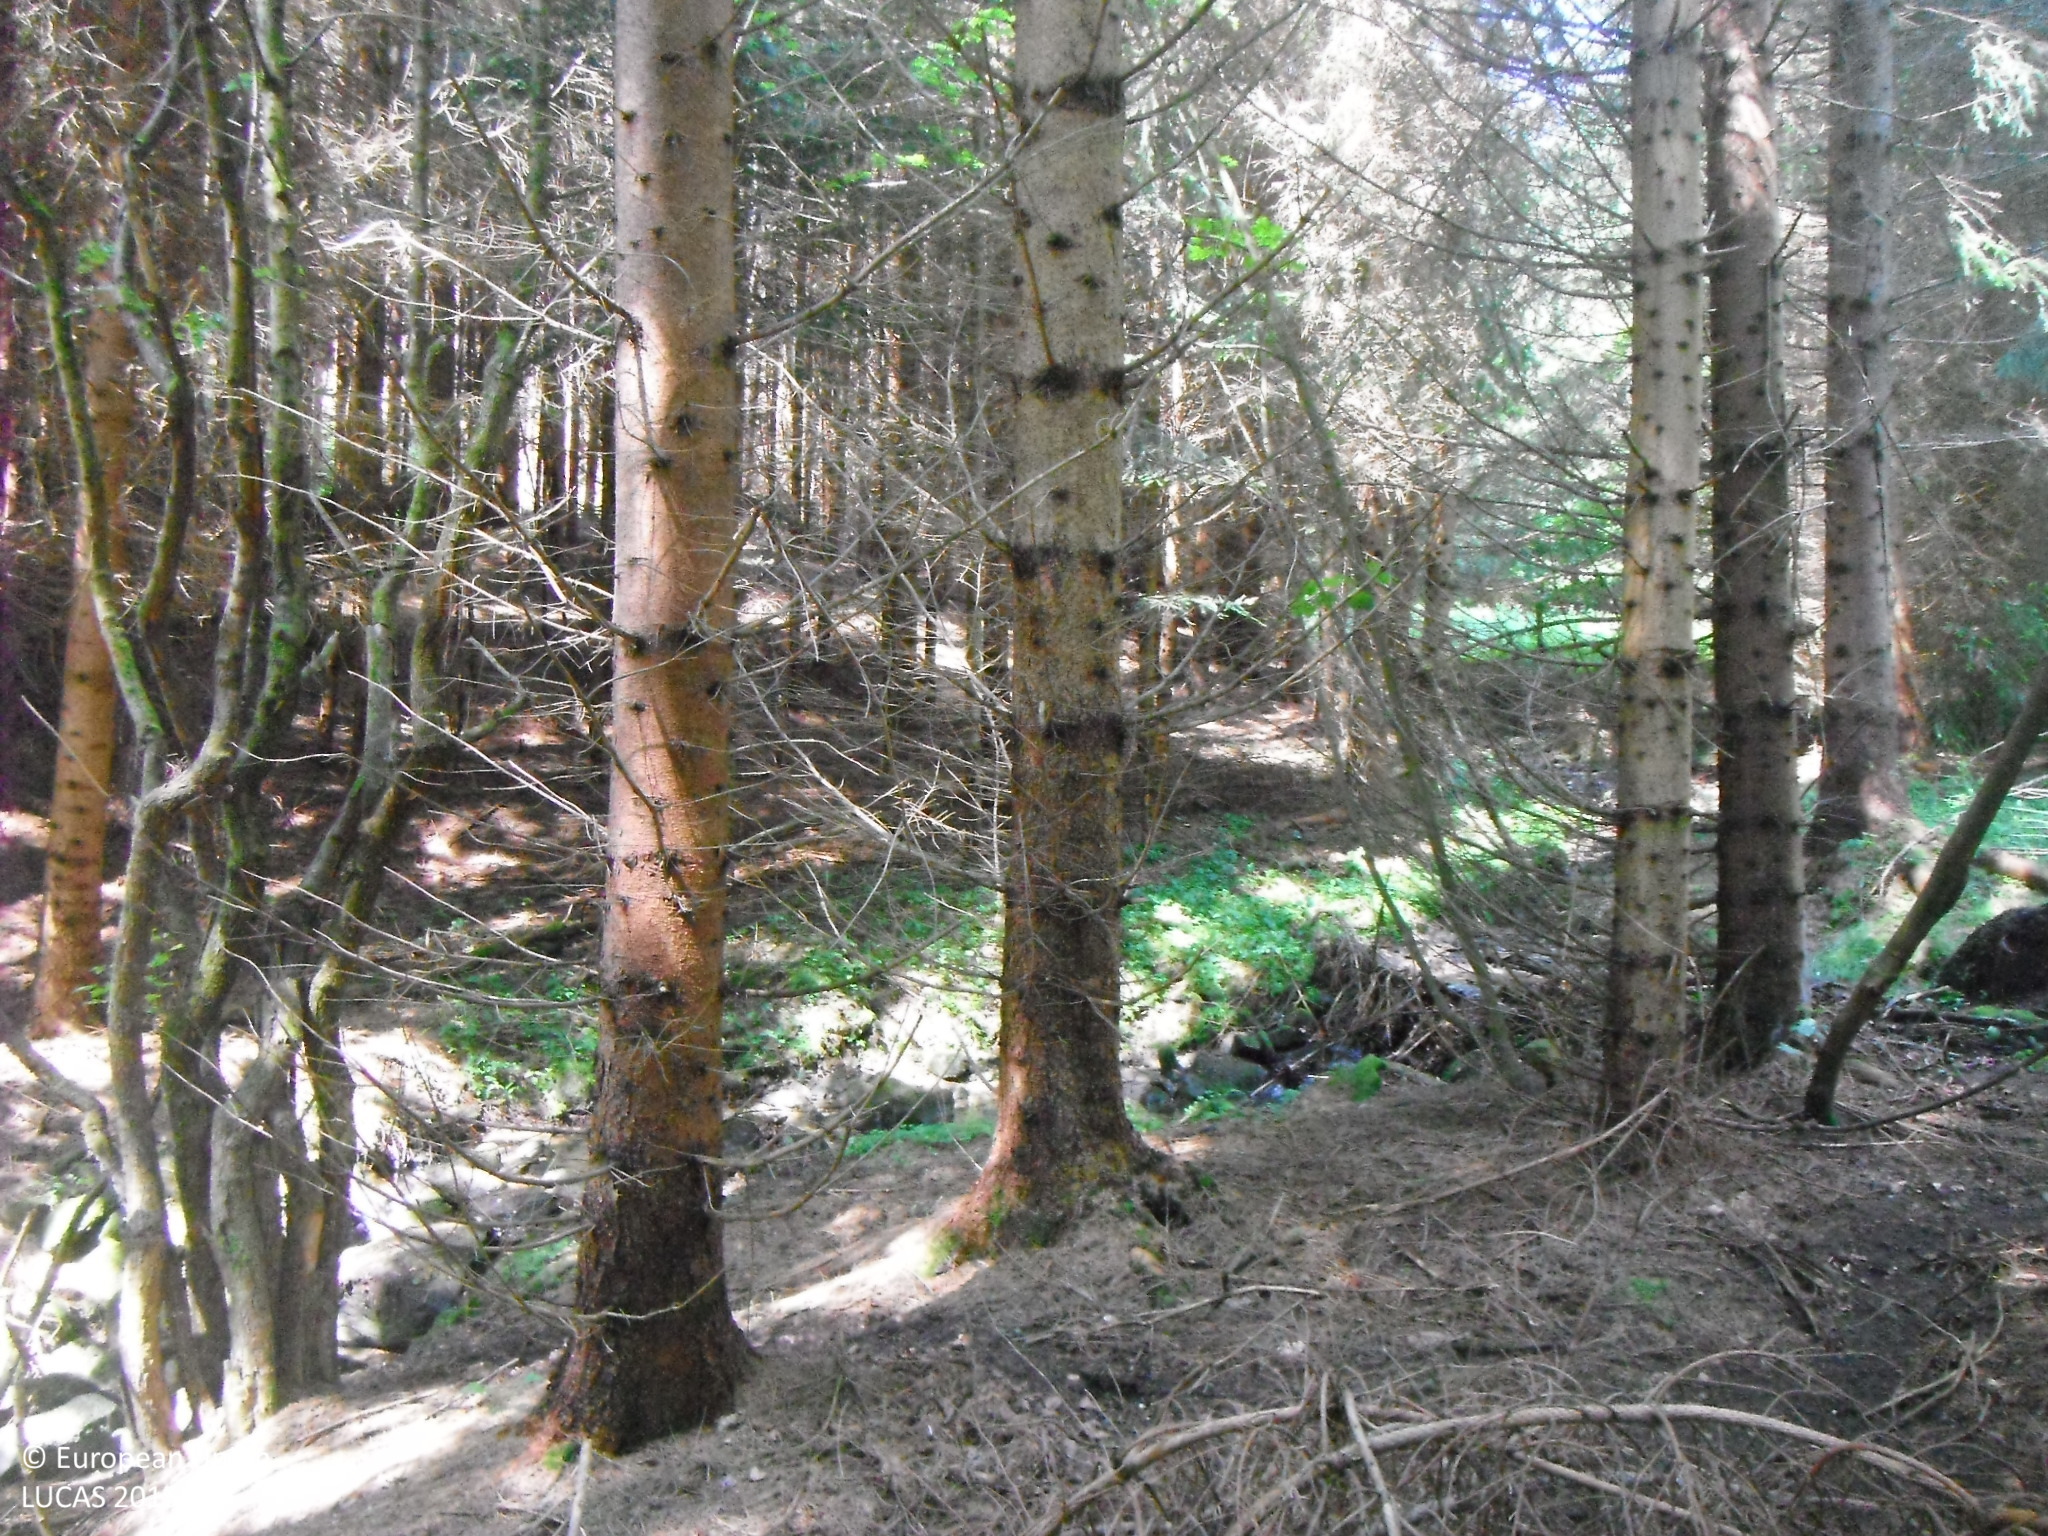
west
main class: Woodland
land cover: Spruce dominated coniferous woodland
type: alpine coniferous forest
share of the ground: > 75 %
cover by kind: coniferous forest trees 95 %, herbaceous plants 5 %
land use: Forestry
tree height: > 5 m
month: June
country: SK
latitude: 48.4510
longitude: 19.4481
